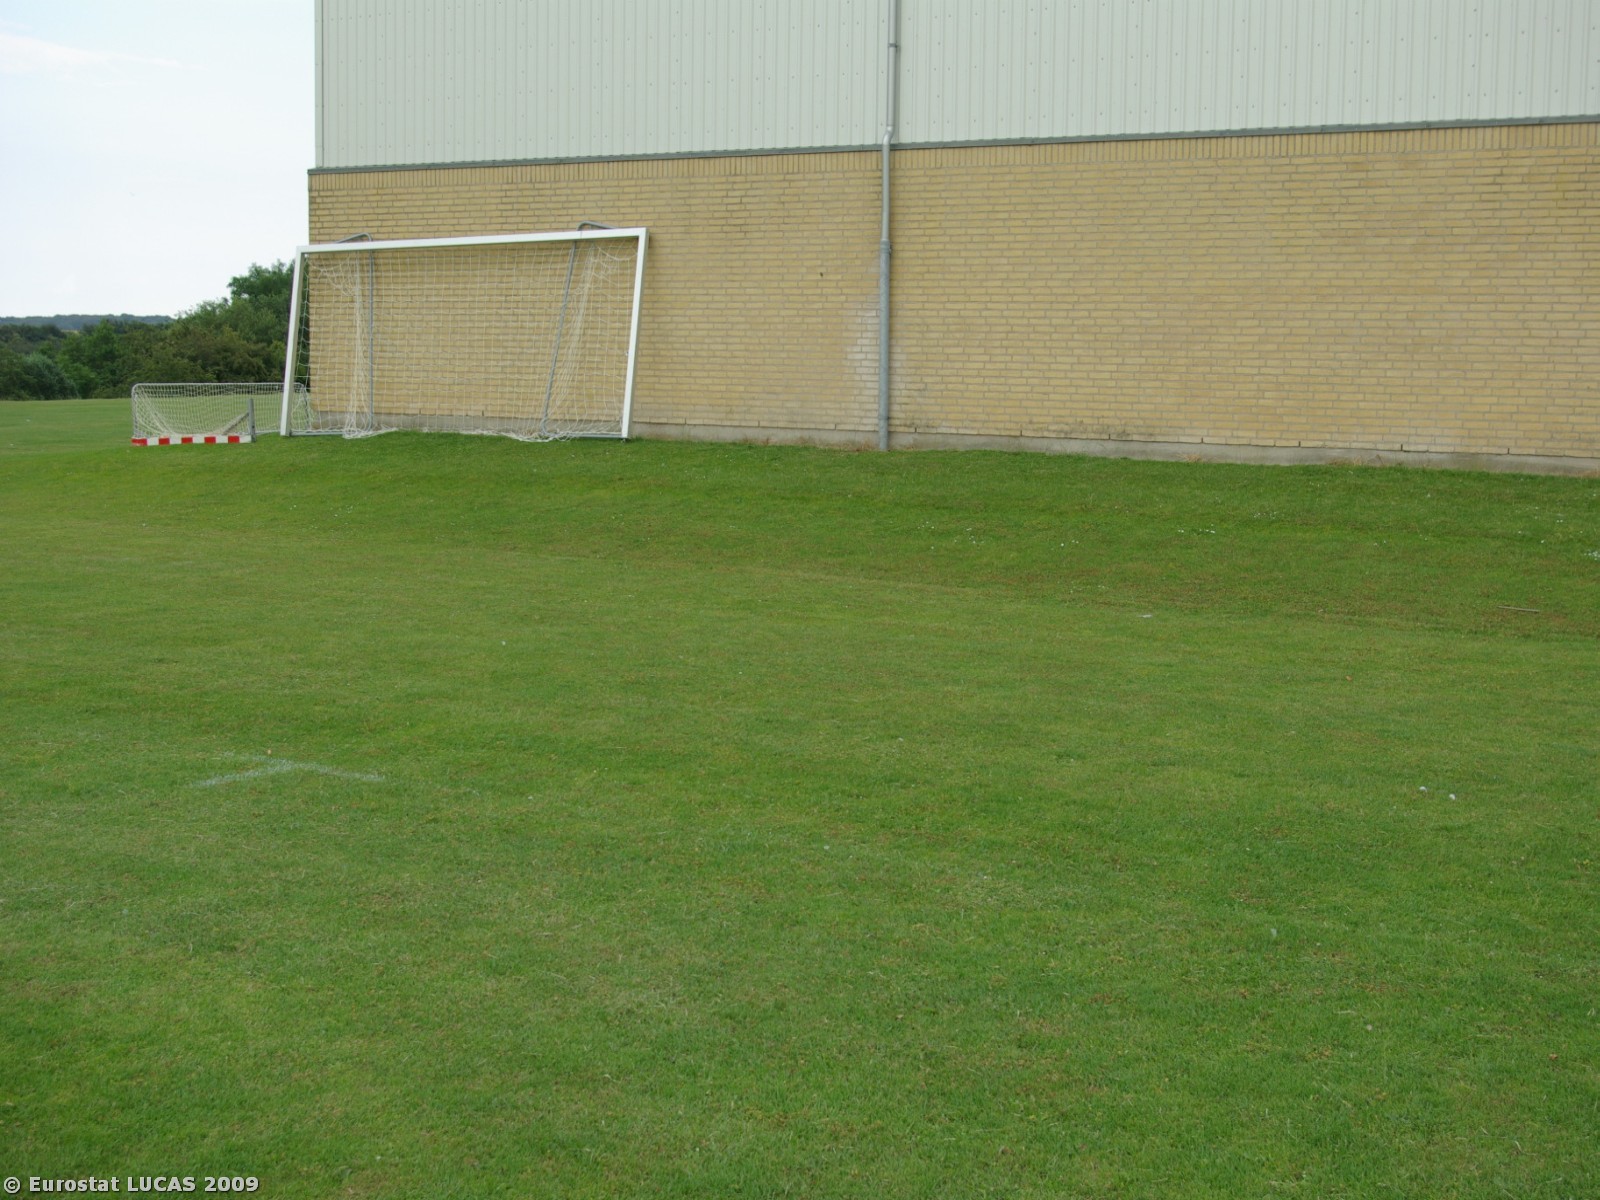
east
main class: Grassland
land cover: Grassland without tree/shrub cover
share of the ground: > 75 %
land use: Sport
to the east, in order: Grassland without tree/shrub cover; Artificial constructions in urban areas; Grassland without tree/shrub cover; Broadleaved woodland; Grassland without tree/shrub cover; Broadleaved woodland; Grassland without tree/shrub cover
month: July
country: DK
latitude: 55.0551
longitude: 9.7654
